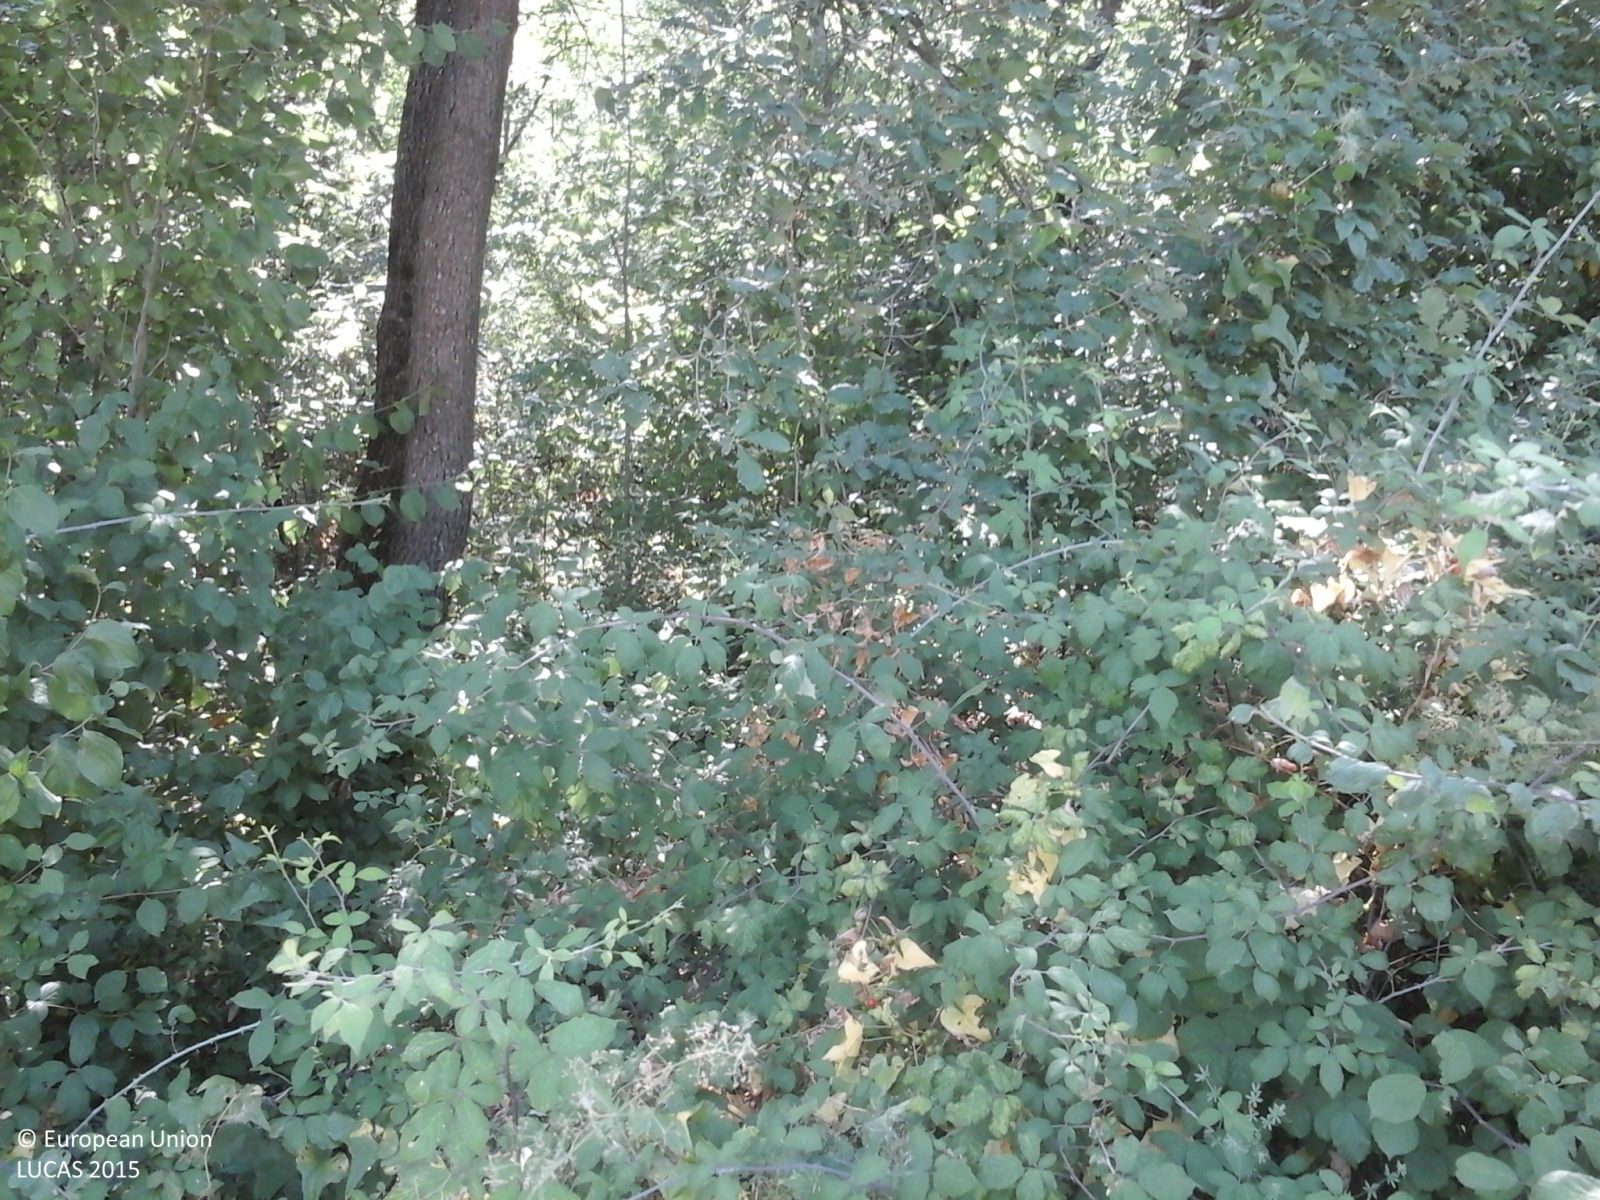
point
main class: Woodland
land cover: Broadleaved woodland
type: thermophilous deciduous forest
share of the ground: > 75 %
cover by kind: broadleaved forest trees 90 %, shrubs 5 %, herbaceous plants 5 %
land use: Forestry
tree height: > 5 m
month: July
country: IT
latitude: 43.2138
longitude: 13.3271
